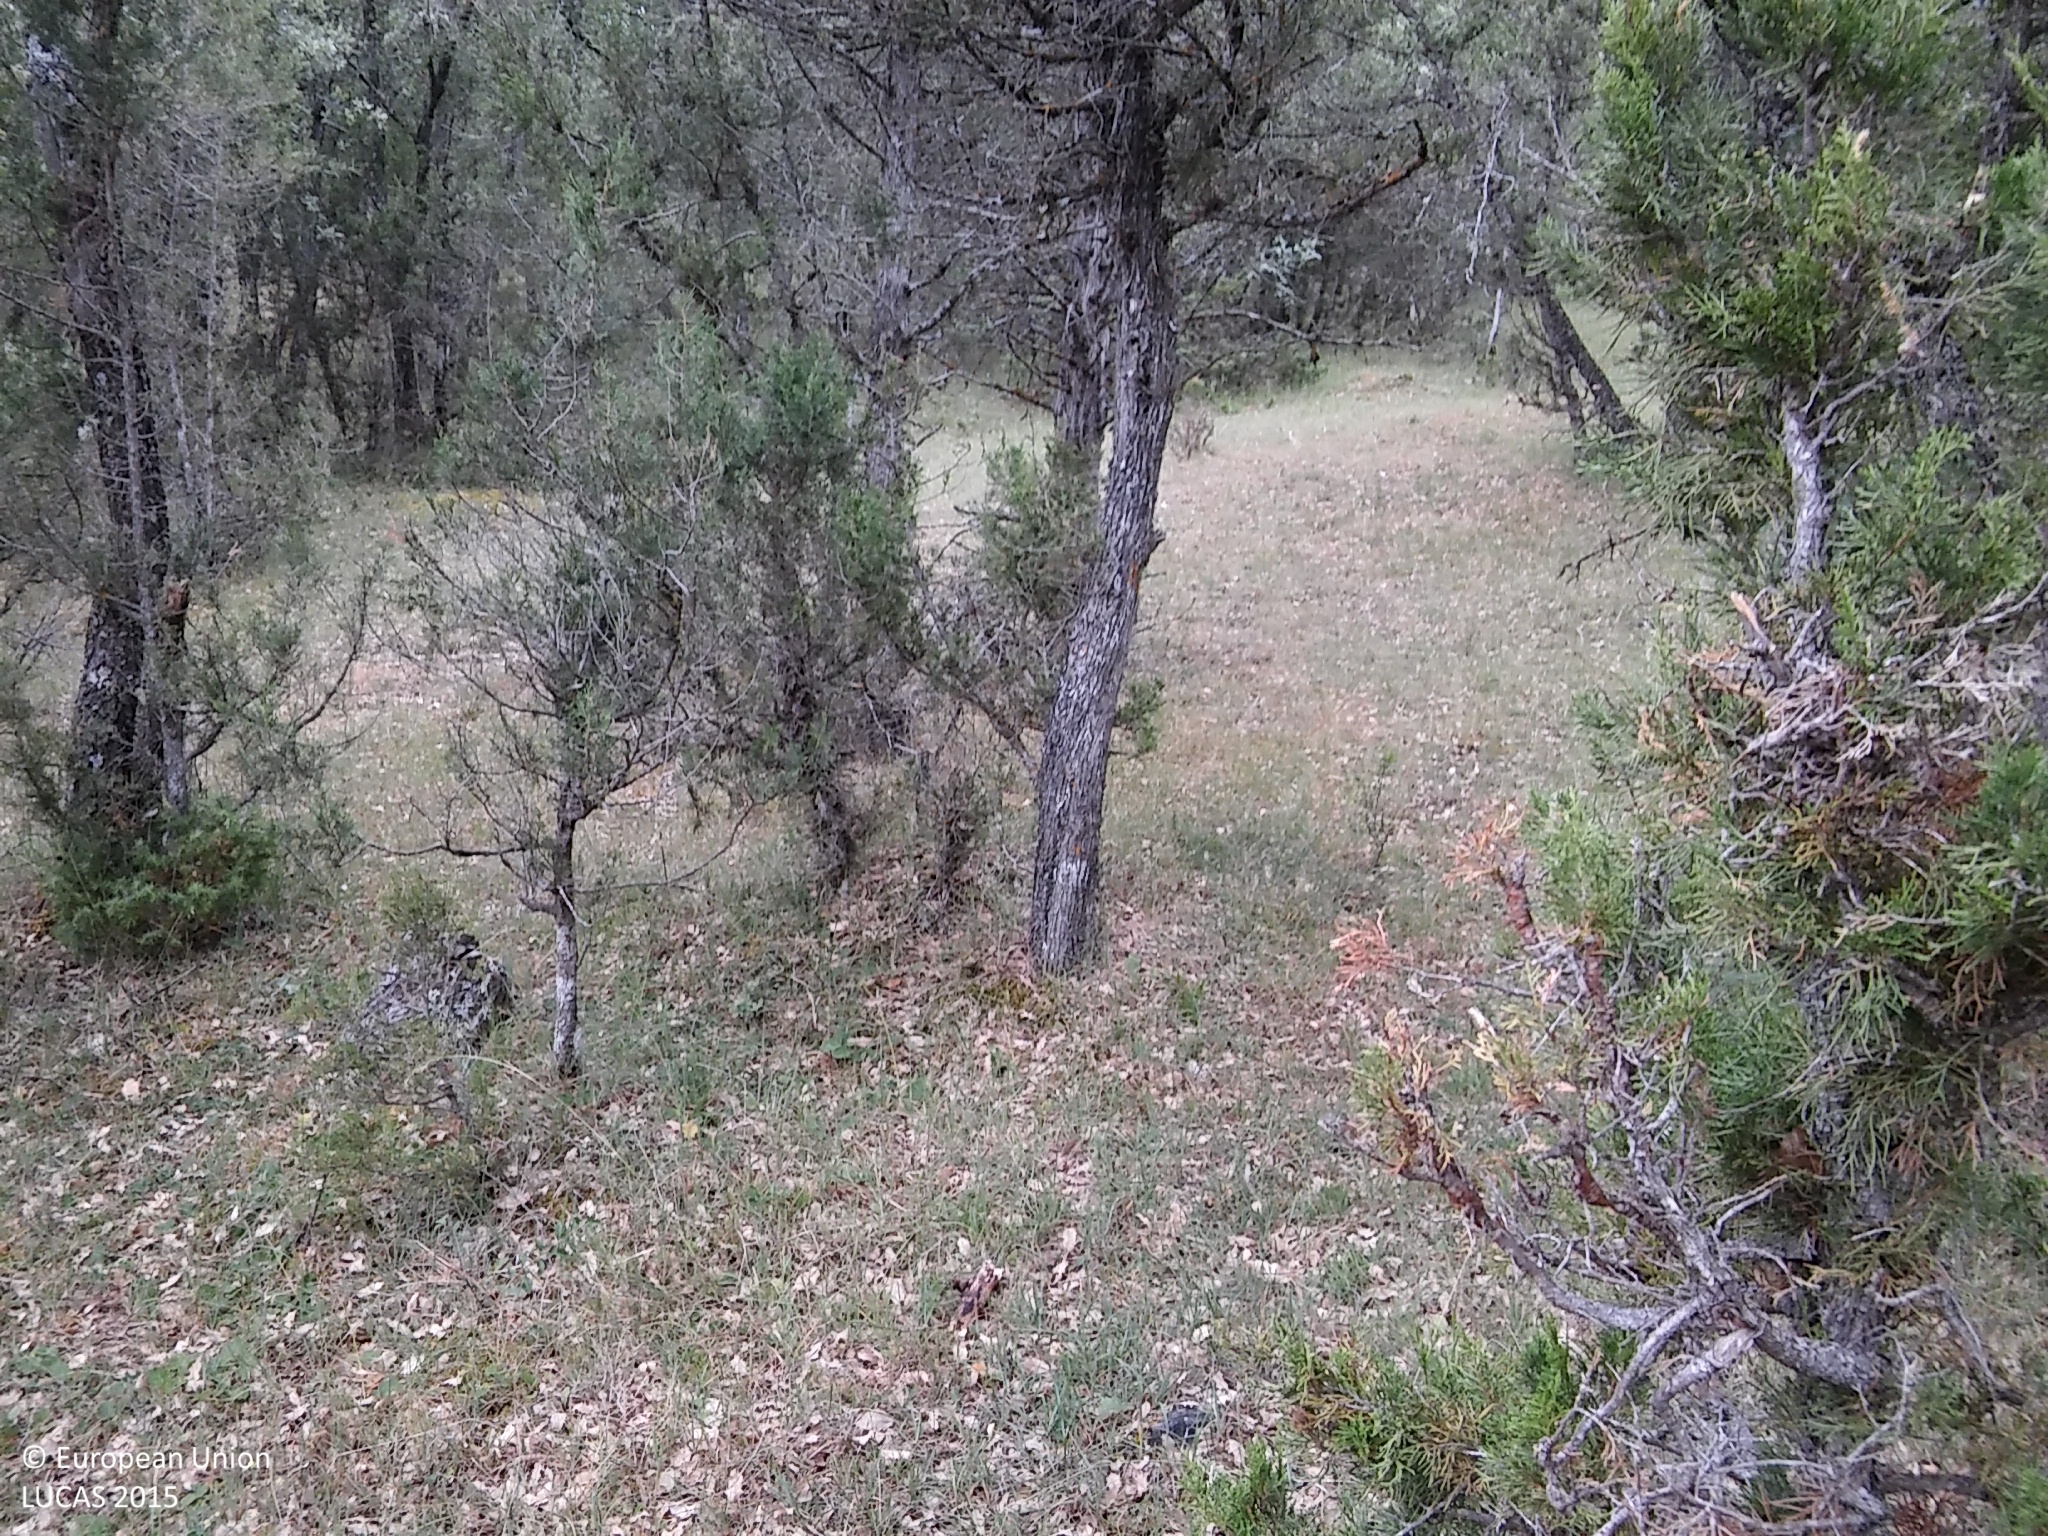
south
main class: Woodland
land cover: Broadleaved woodland
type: acidophilous oak and oak-birch forest
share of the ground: 50 - 75 %
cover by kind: broadleaved forest trees 70 %, herbaceous plants 15 %, unconsolidated bare surface 10 %, shrubs 5 %
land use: Agriculture (excluding fallow land and kitchen gardens)
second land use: Forestry
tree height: > 5 m
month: June
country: ES
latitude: 41.2153
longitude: -3.6318
